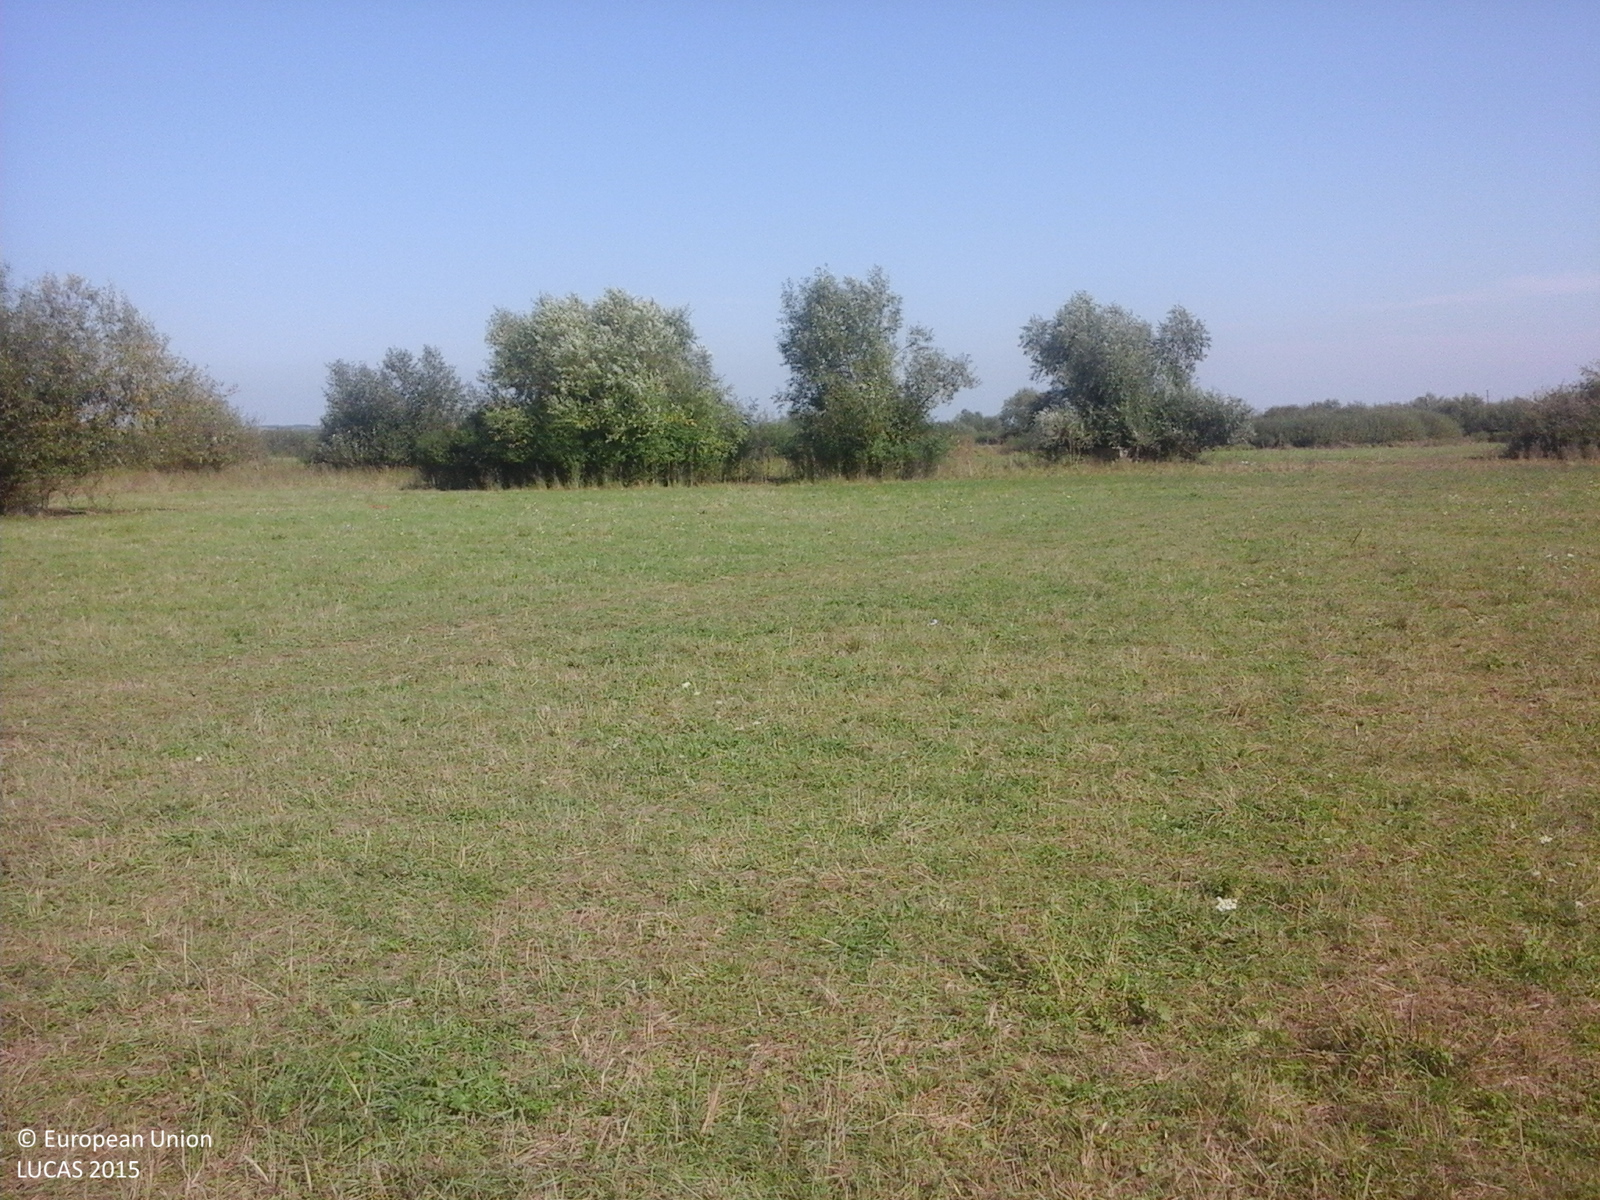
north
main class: Grassland
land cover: Grassland without tree/shrub cover
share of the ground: > 75 %
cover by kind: herbaceous plants 100 %
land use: Agriculture (excluding fallow land and kitchen gardens)
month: September
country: RO
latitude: 47.4222
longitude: 22.7731
